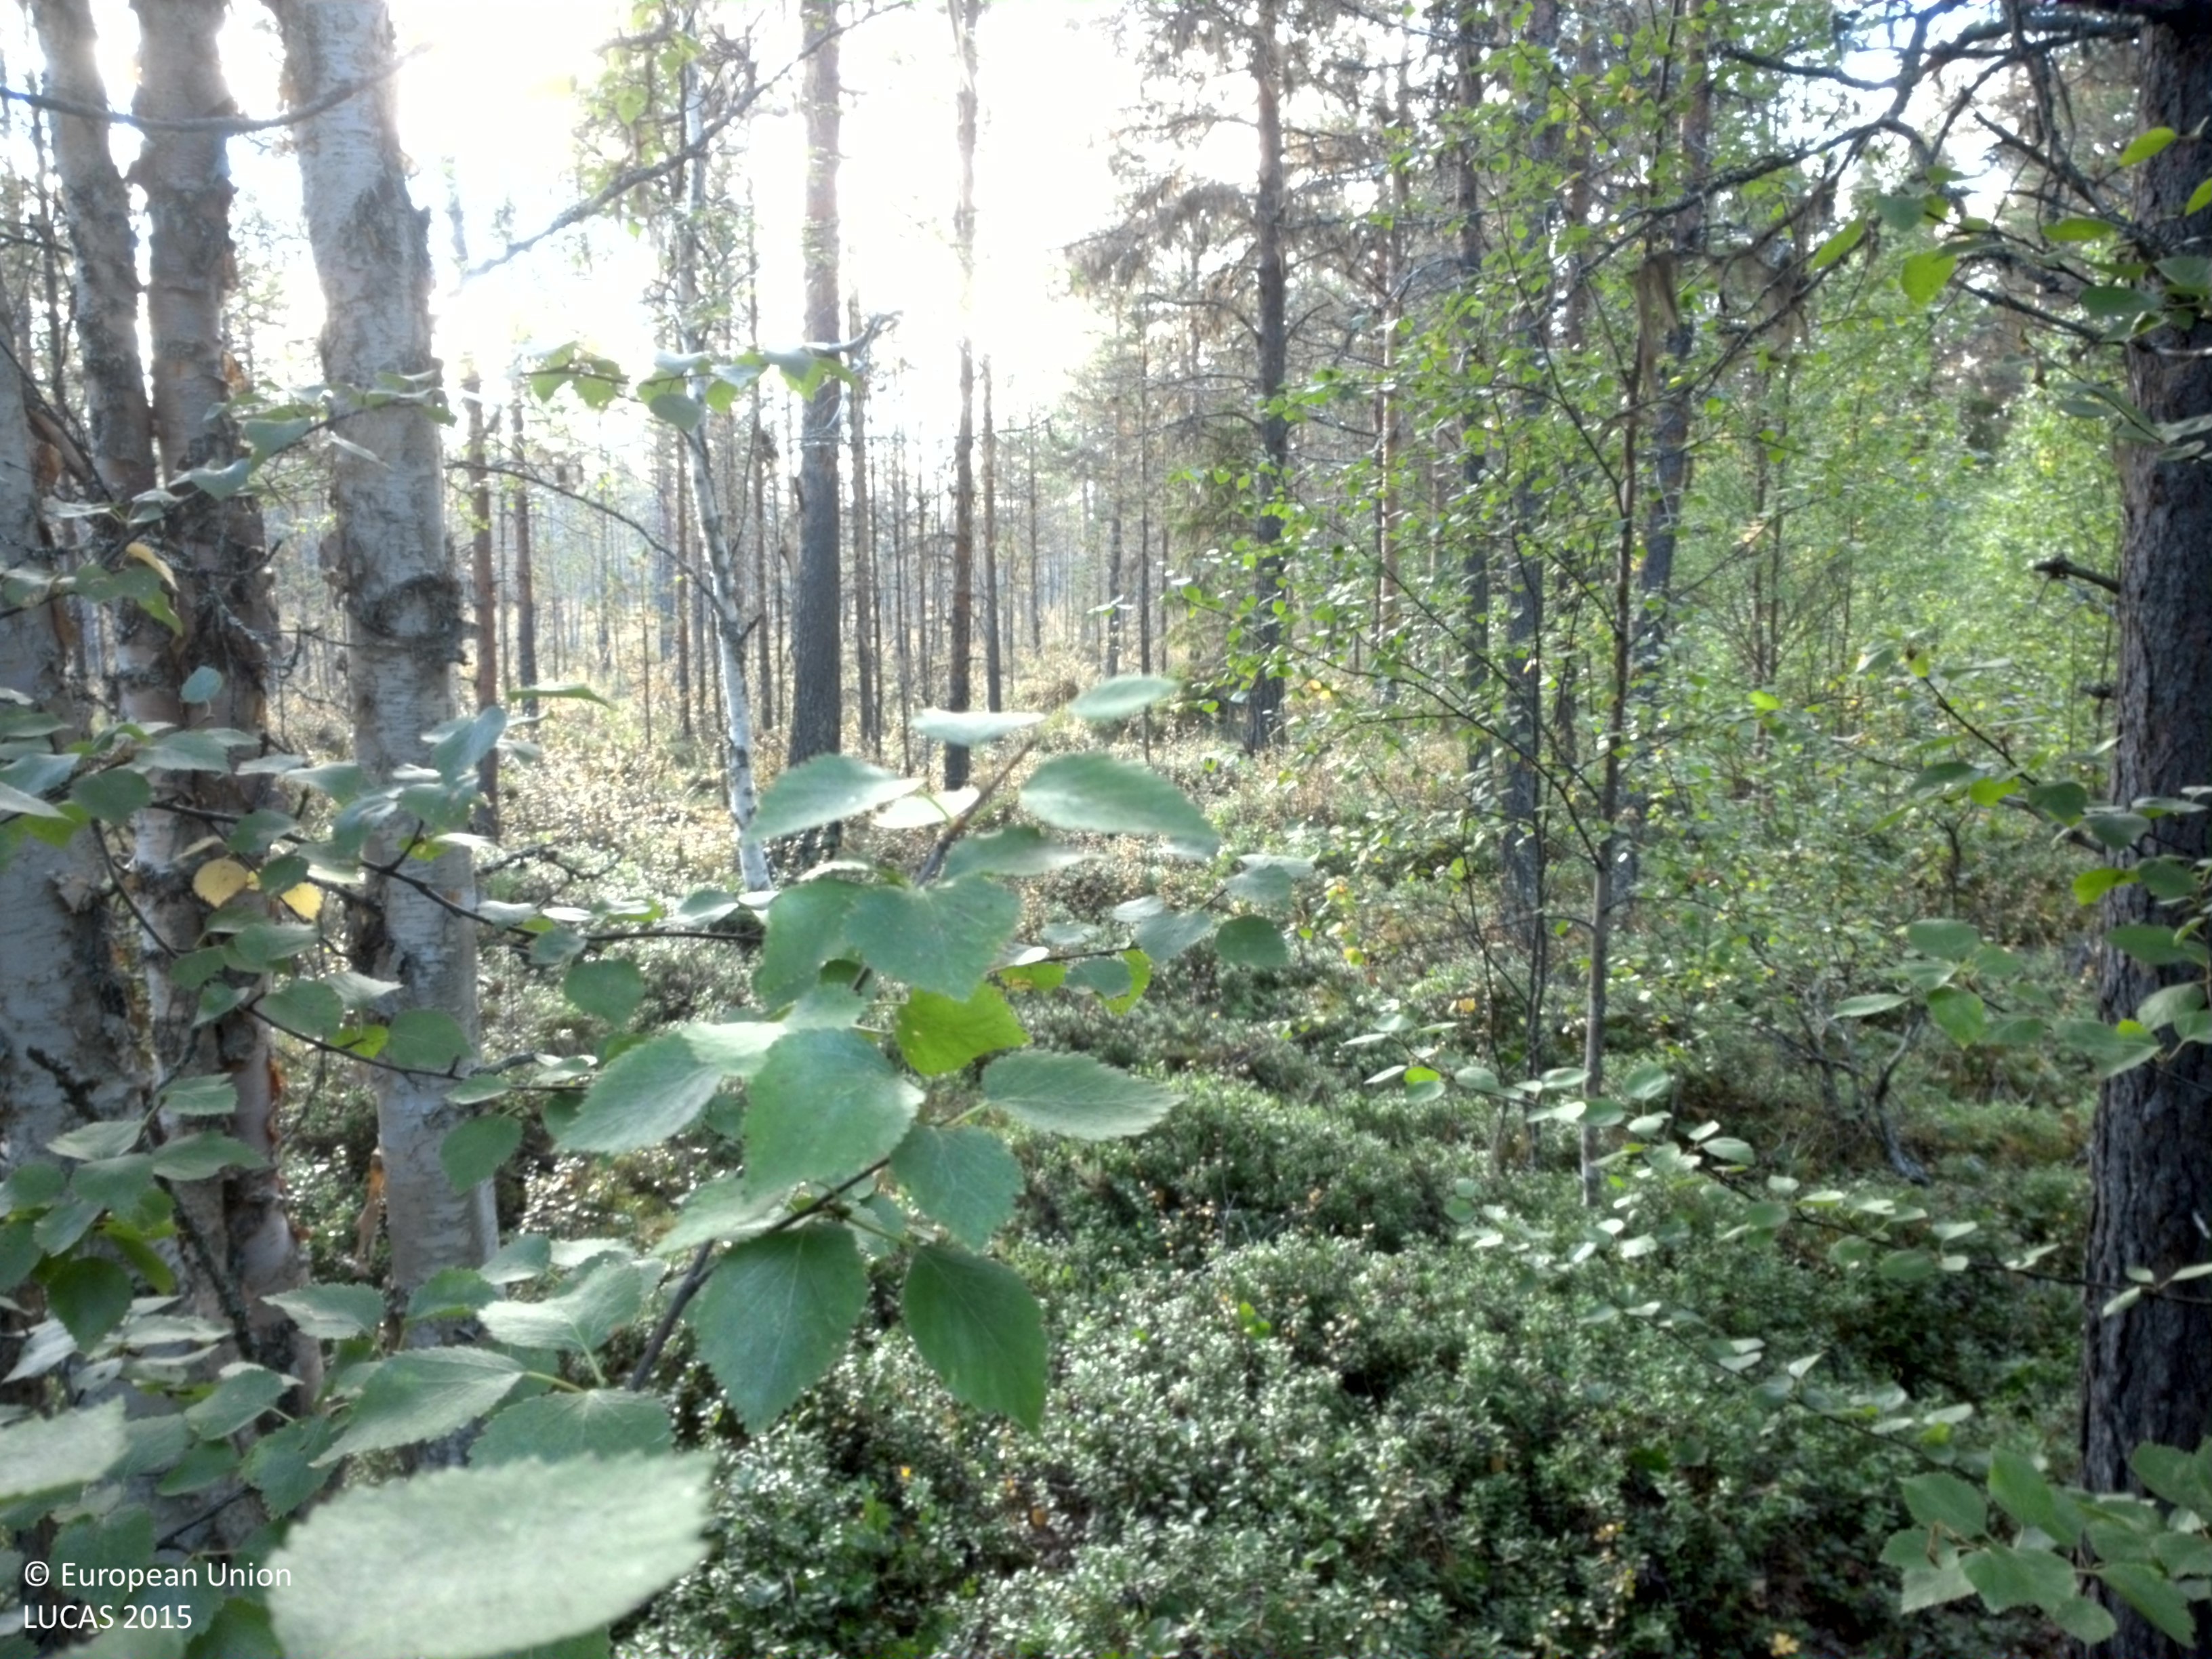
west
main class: Woodland
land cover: Pine dominated mixed woodland
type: boreal forest
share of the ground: 25 - 50 %
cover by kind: shrubs 45 %, coniferous forest trees 30 %, broadleaved forest trees 10 %, lichens and mosses 10 %, herbaceous plants 5 %
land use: Forestry
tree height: > 5 m
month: August
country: SE
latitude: 64.5773
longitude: 16.8356
